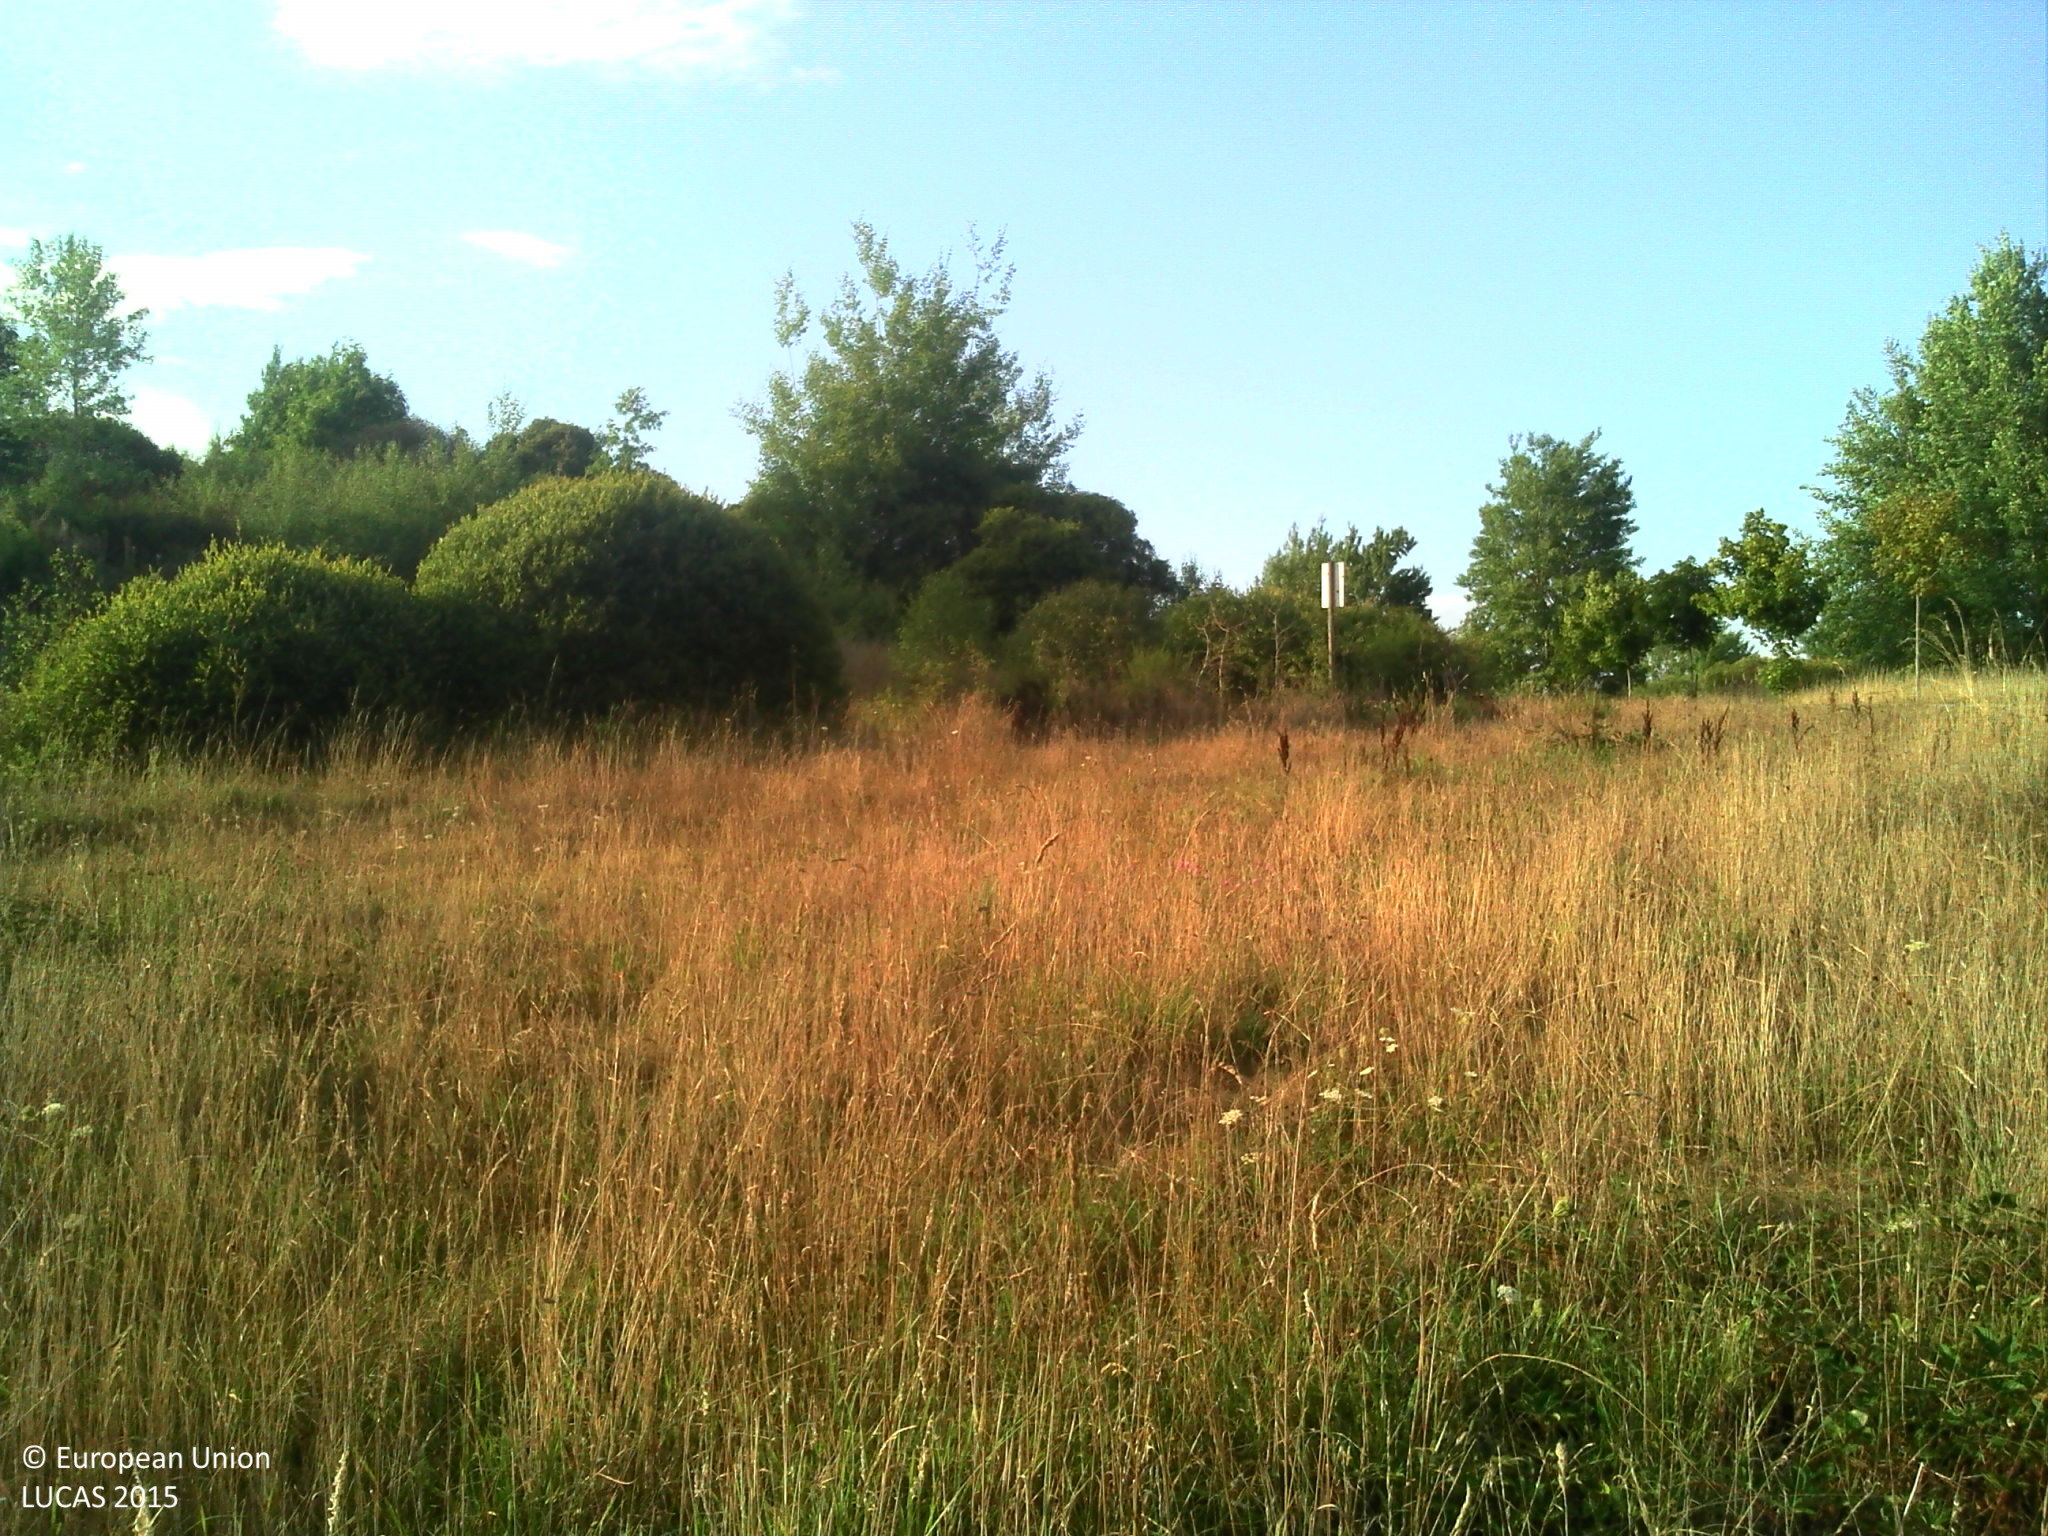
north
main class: Grassland
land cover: Grassland with sparse tree/shrub cover
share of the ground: > 75 %
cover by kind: herbaceous plants 90 %, broadleaved forest trees 5 %, shrubs 5 %
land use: Semi-natural and natural areas not in use
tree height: > 5 m
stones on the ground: < 10 %
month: August
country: FR
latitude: 46.1933
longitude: 2.2072
